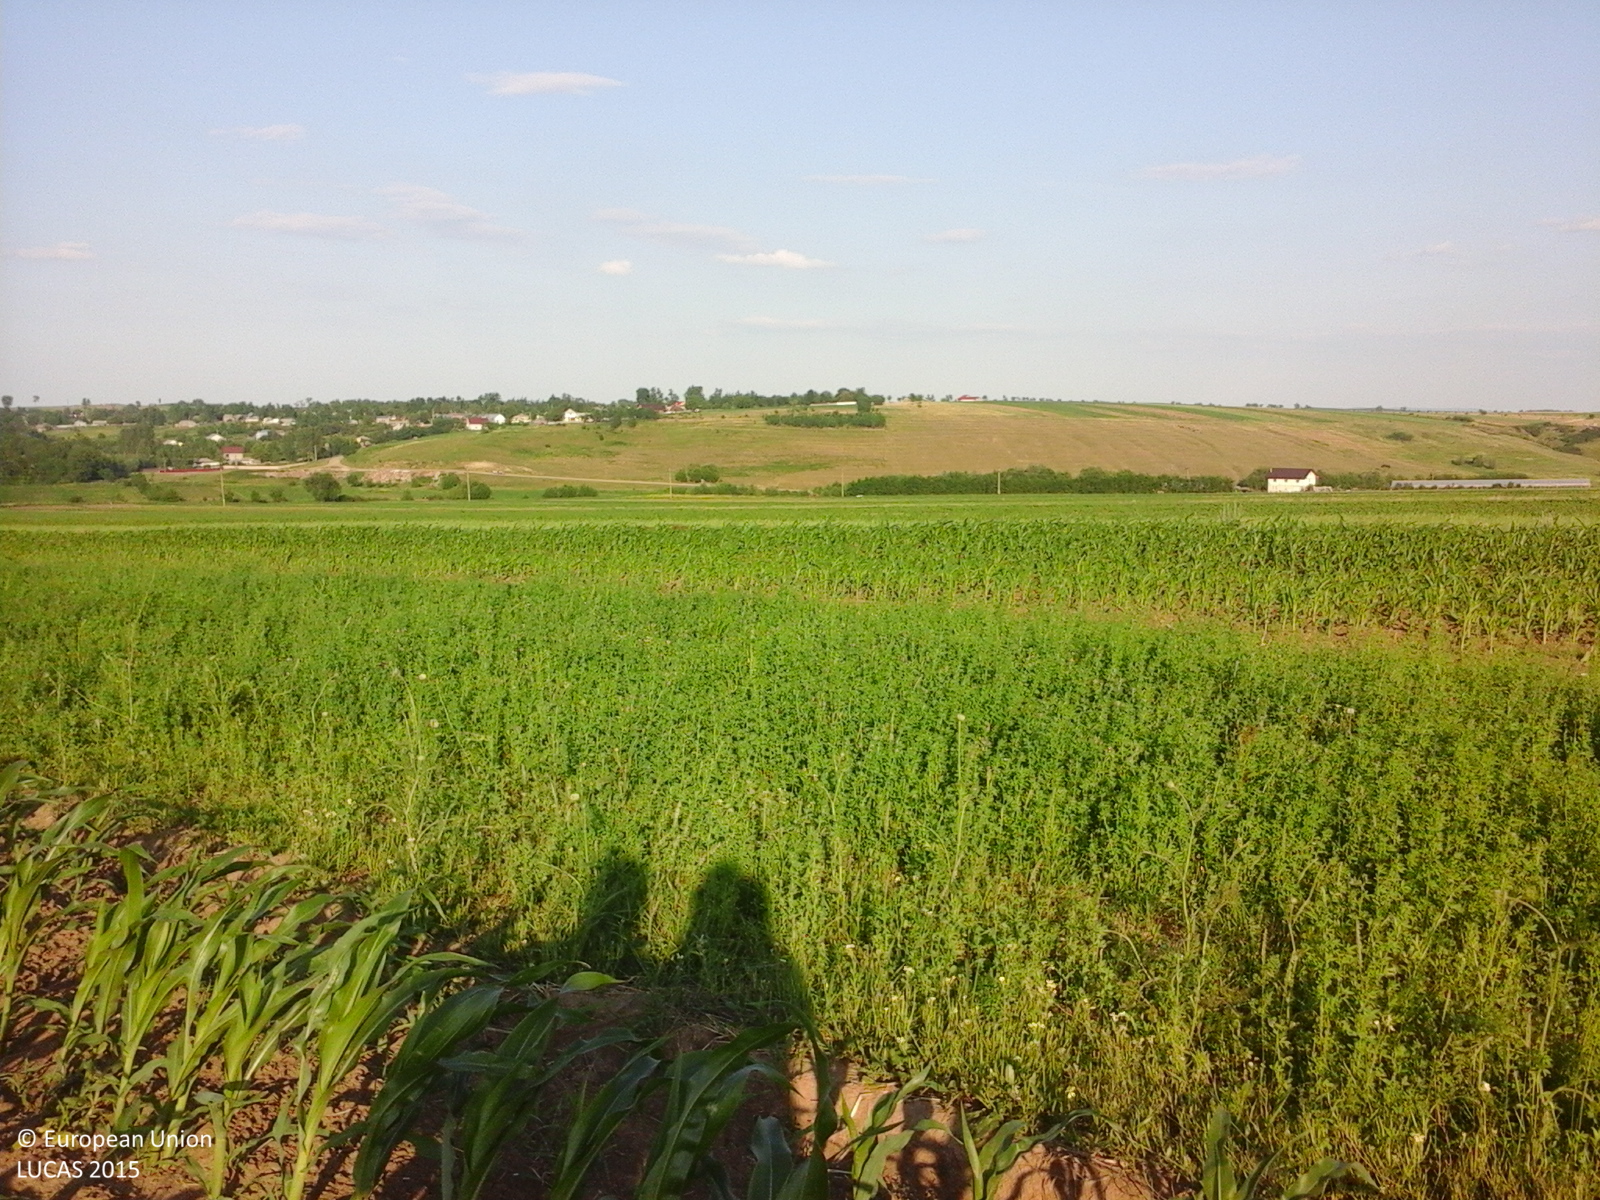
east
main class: Cropland
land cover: Maize
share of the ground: 25 - 50 %
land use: Agriculture (excluding fallow land and kitchen gardens)
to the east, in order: Maize; Spontaneously vegetated surfaces; Maize; Grass margins; Ditches and canals; Grass margins; Soya; Potatoes; Maize; Sunflower
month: June
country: RO
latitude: 47.7080
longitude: 26.4692
